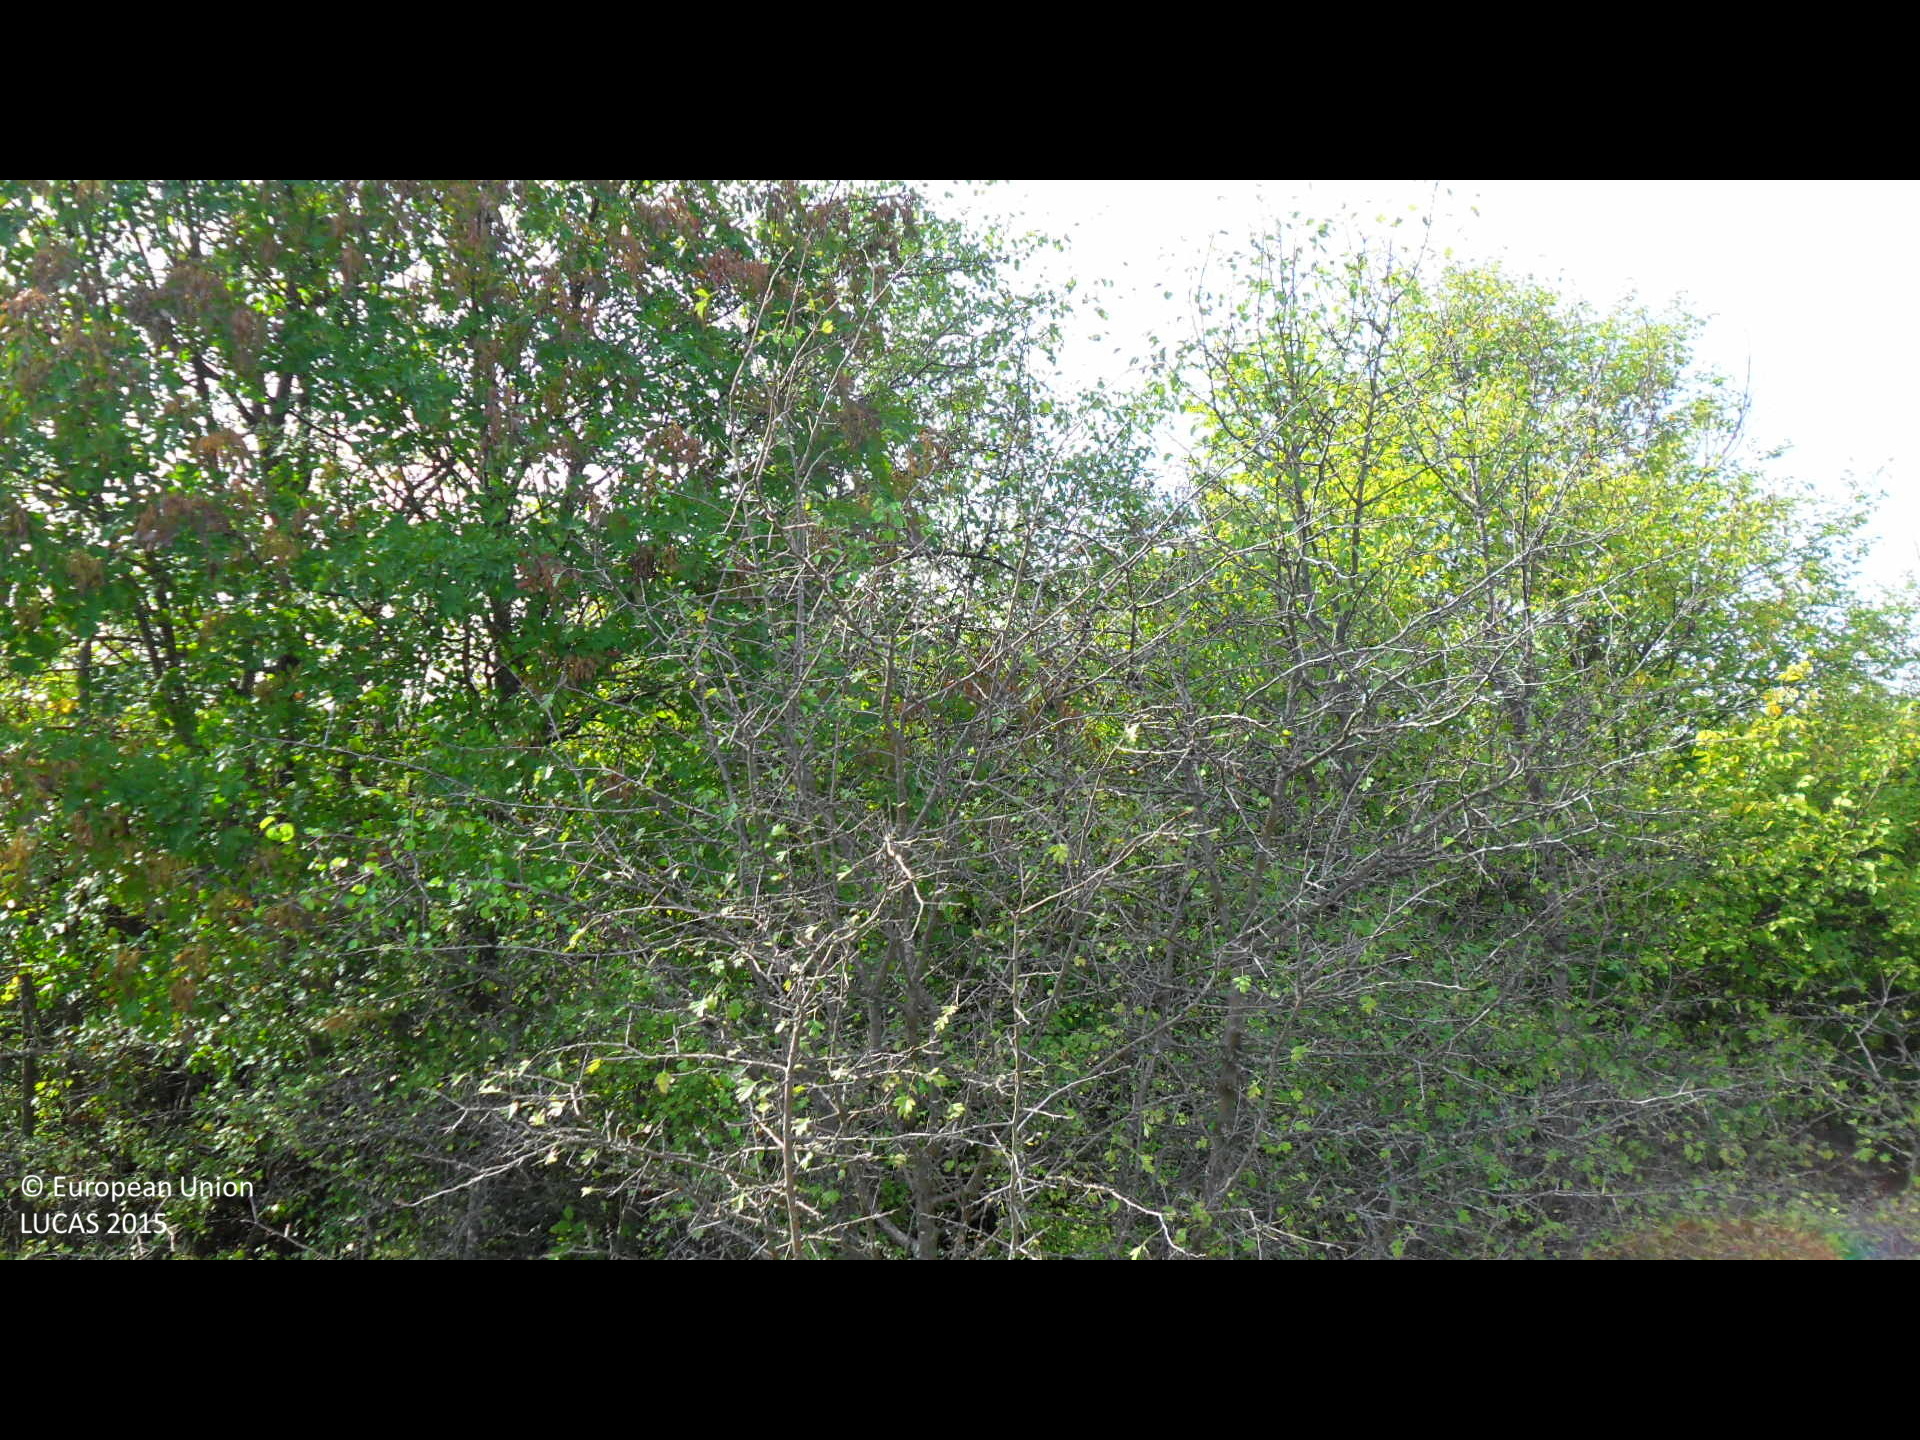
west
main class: Grassland
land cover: Grassland without tree/shrub cover
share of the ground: > 75 %
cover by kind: herbaceous plants 100 %
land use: Agriculture (excluding fallow land and kitchen gardens)
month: September
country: BG
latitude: 43.0179
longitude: 26.5043
